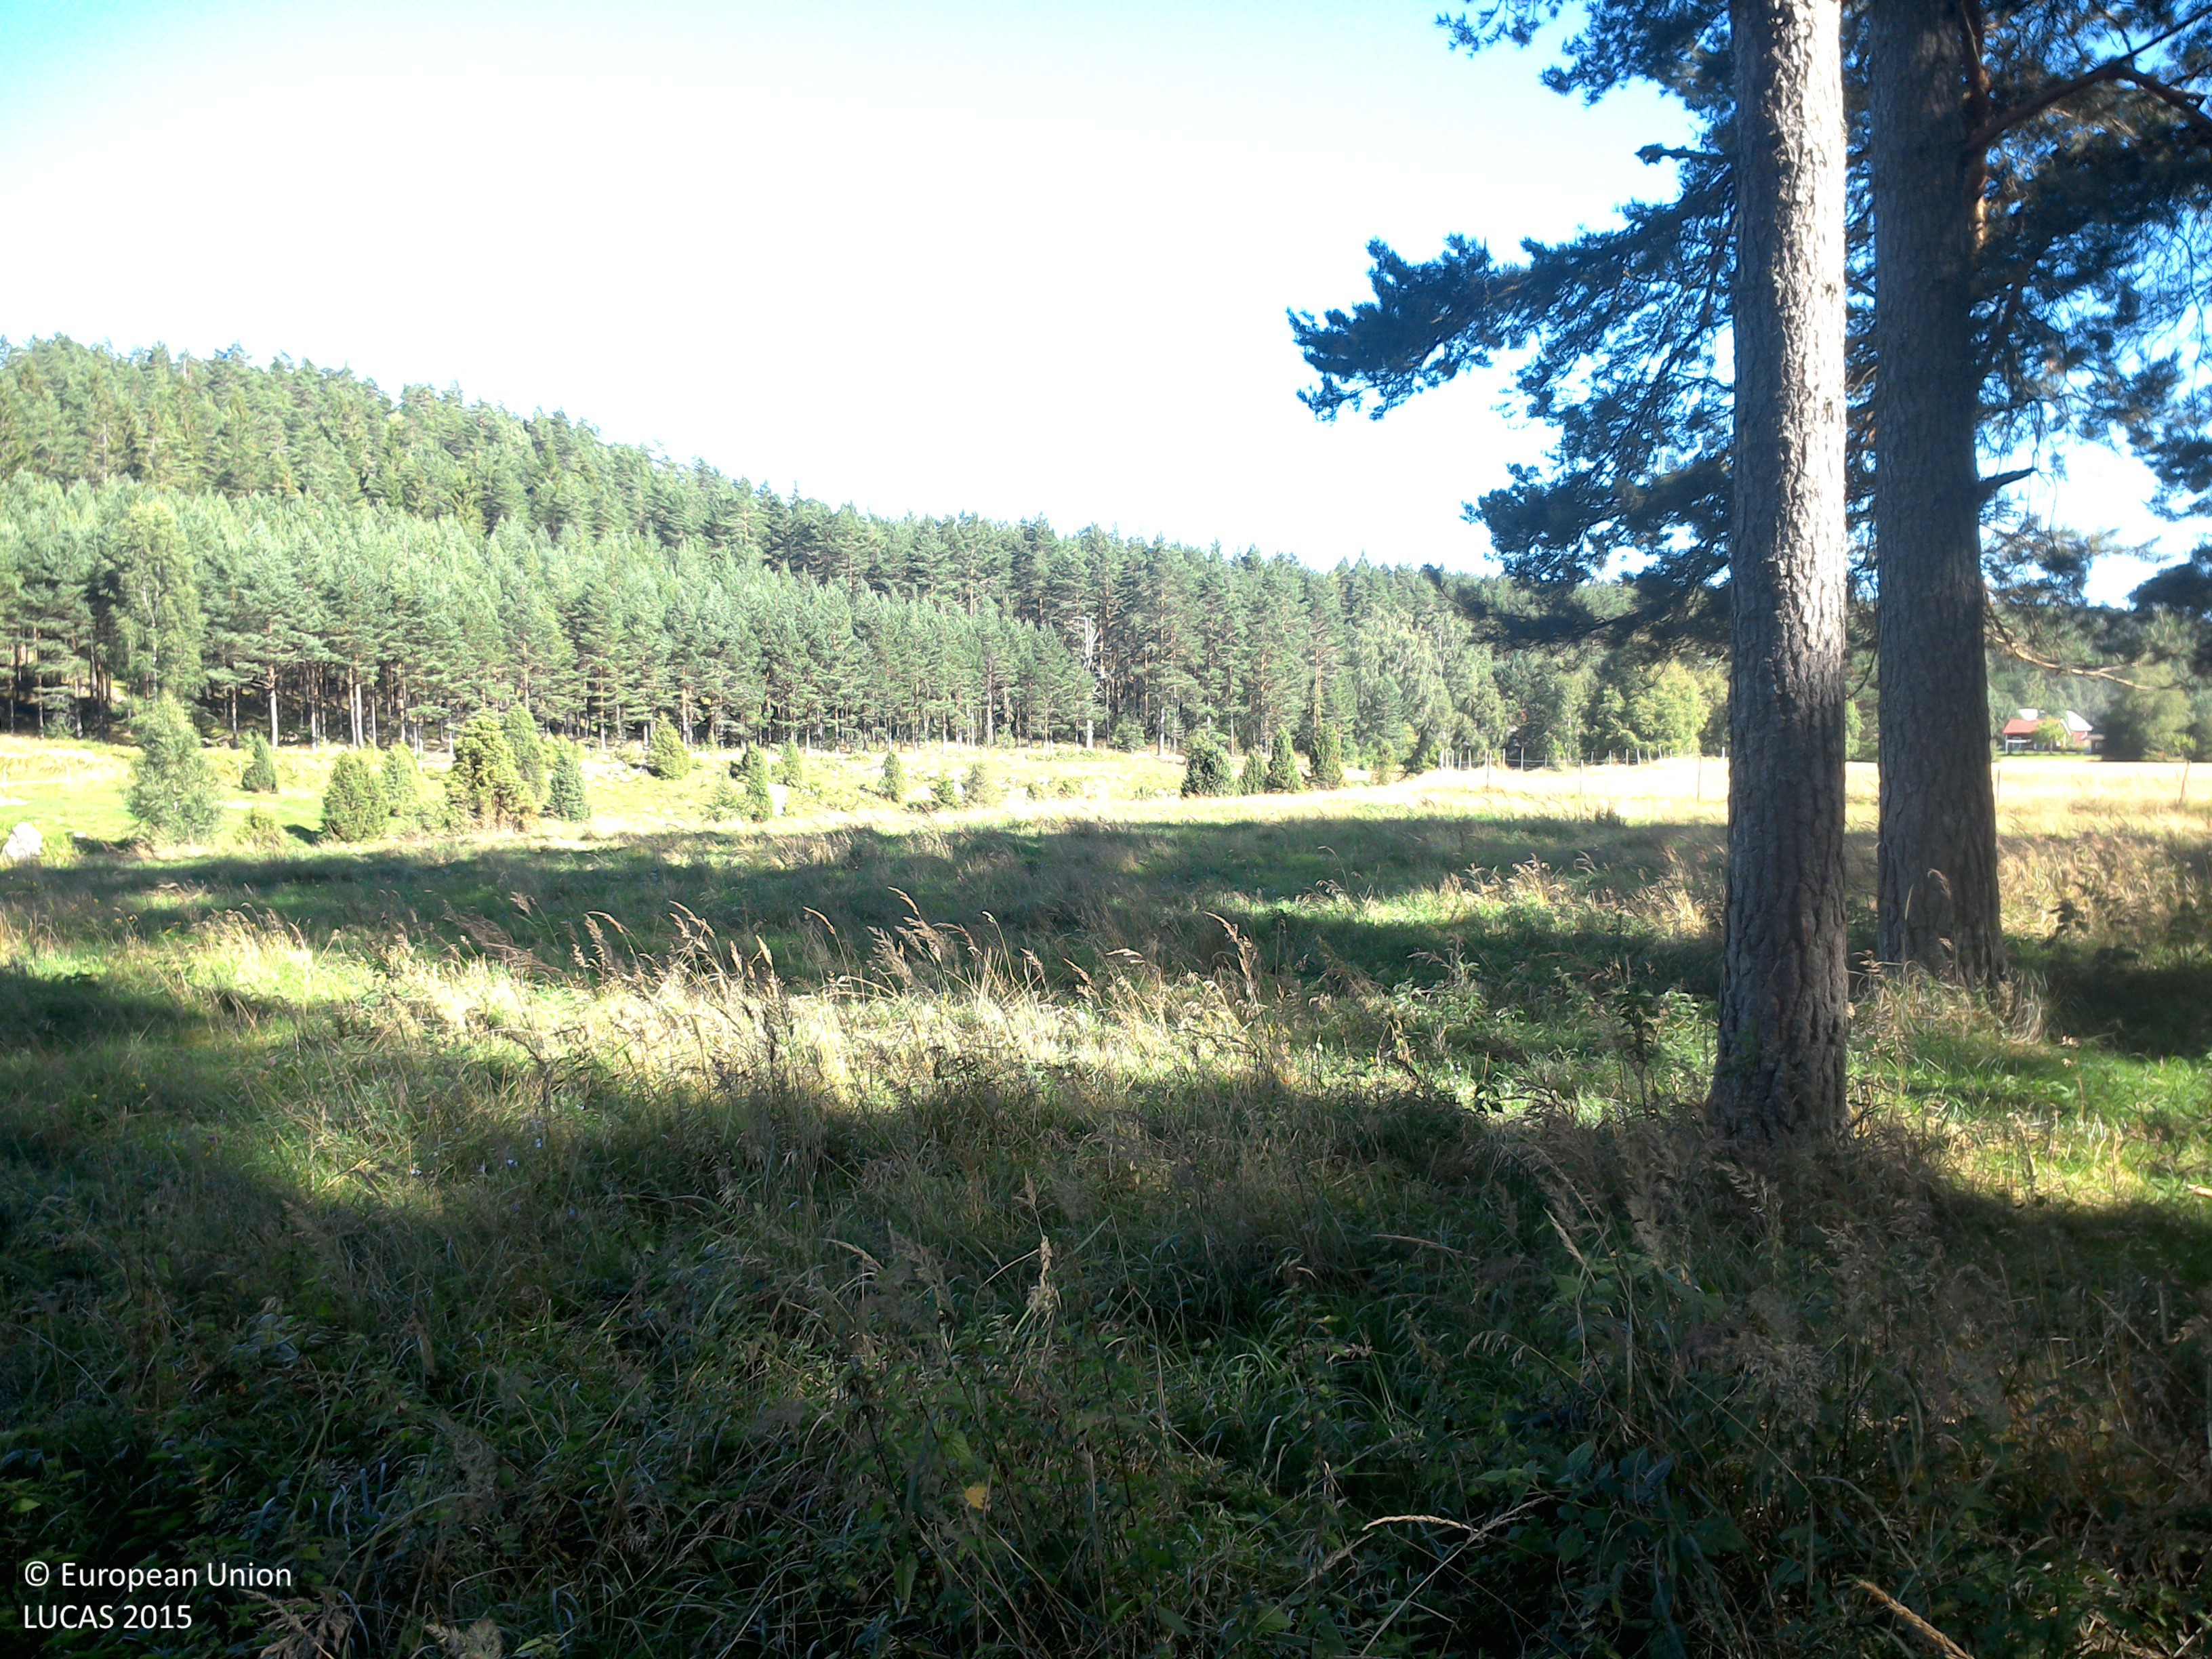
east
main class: Woodland
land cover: Pine dominated coniferous woodland
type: boreal forest
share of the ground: 50 - 75 %
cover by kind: coniferous forest trees 60 %, herbaceous plants 40 %
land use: Agriculture (excluding fallow land and kitchen gardens)
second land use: Forestry
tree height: > 5 m
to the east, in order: Pine dominated coniferous woodland; Grassland without tree/shrub cover; Grassland with sparse tree/shrub cover; Fences; Grass margins; Paved roads, cycling and walking lanes; Pine dominated coniferous woodland
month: August
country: SE
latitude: 58.0816
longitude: 15.2349
